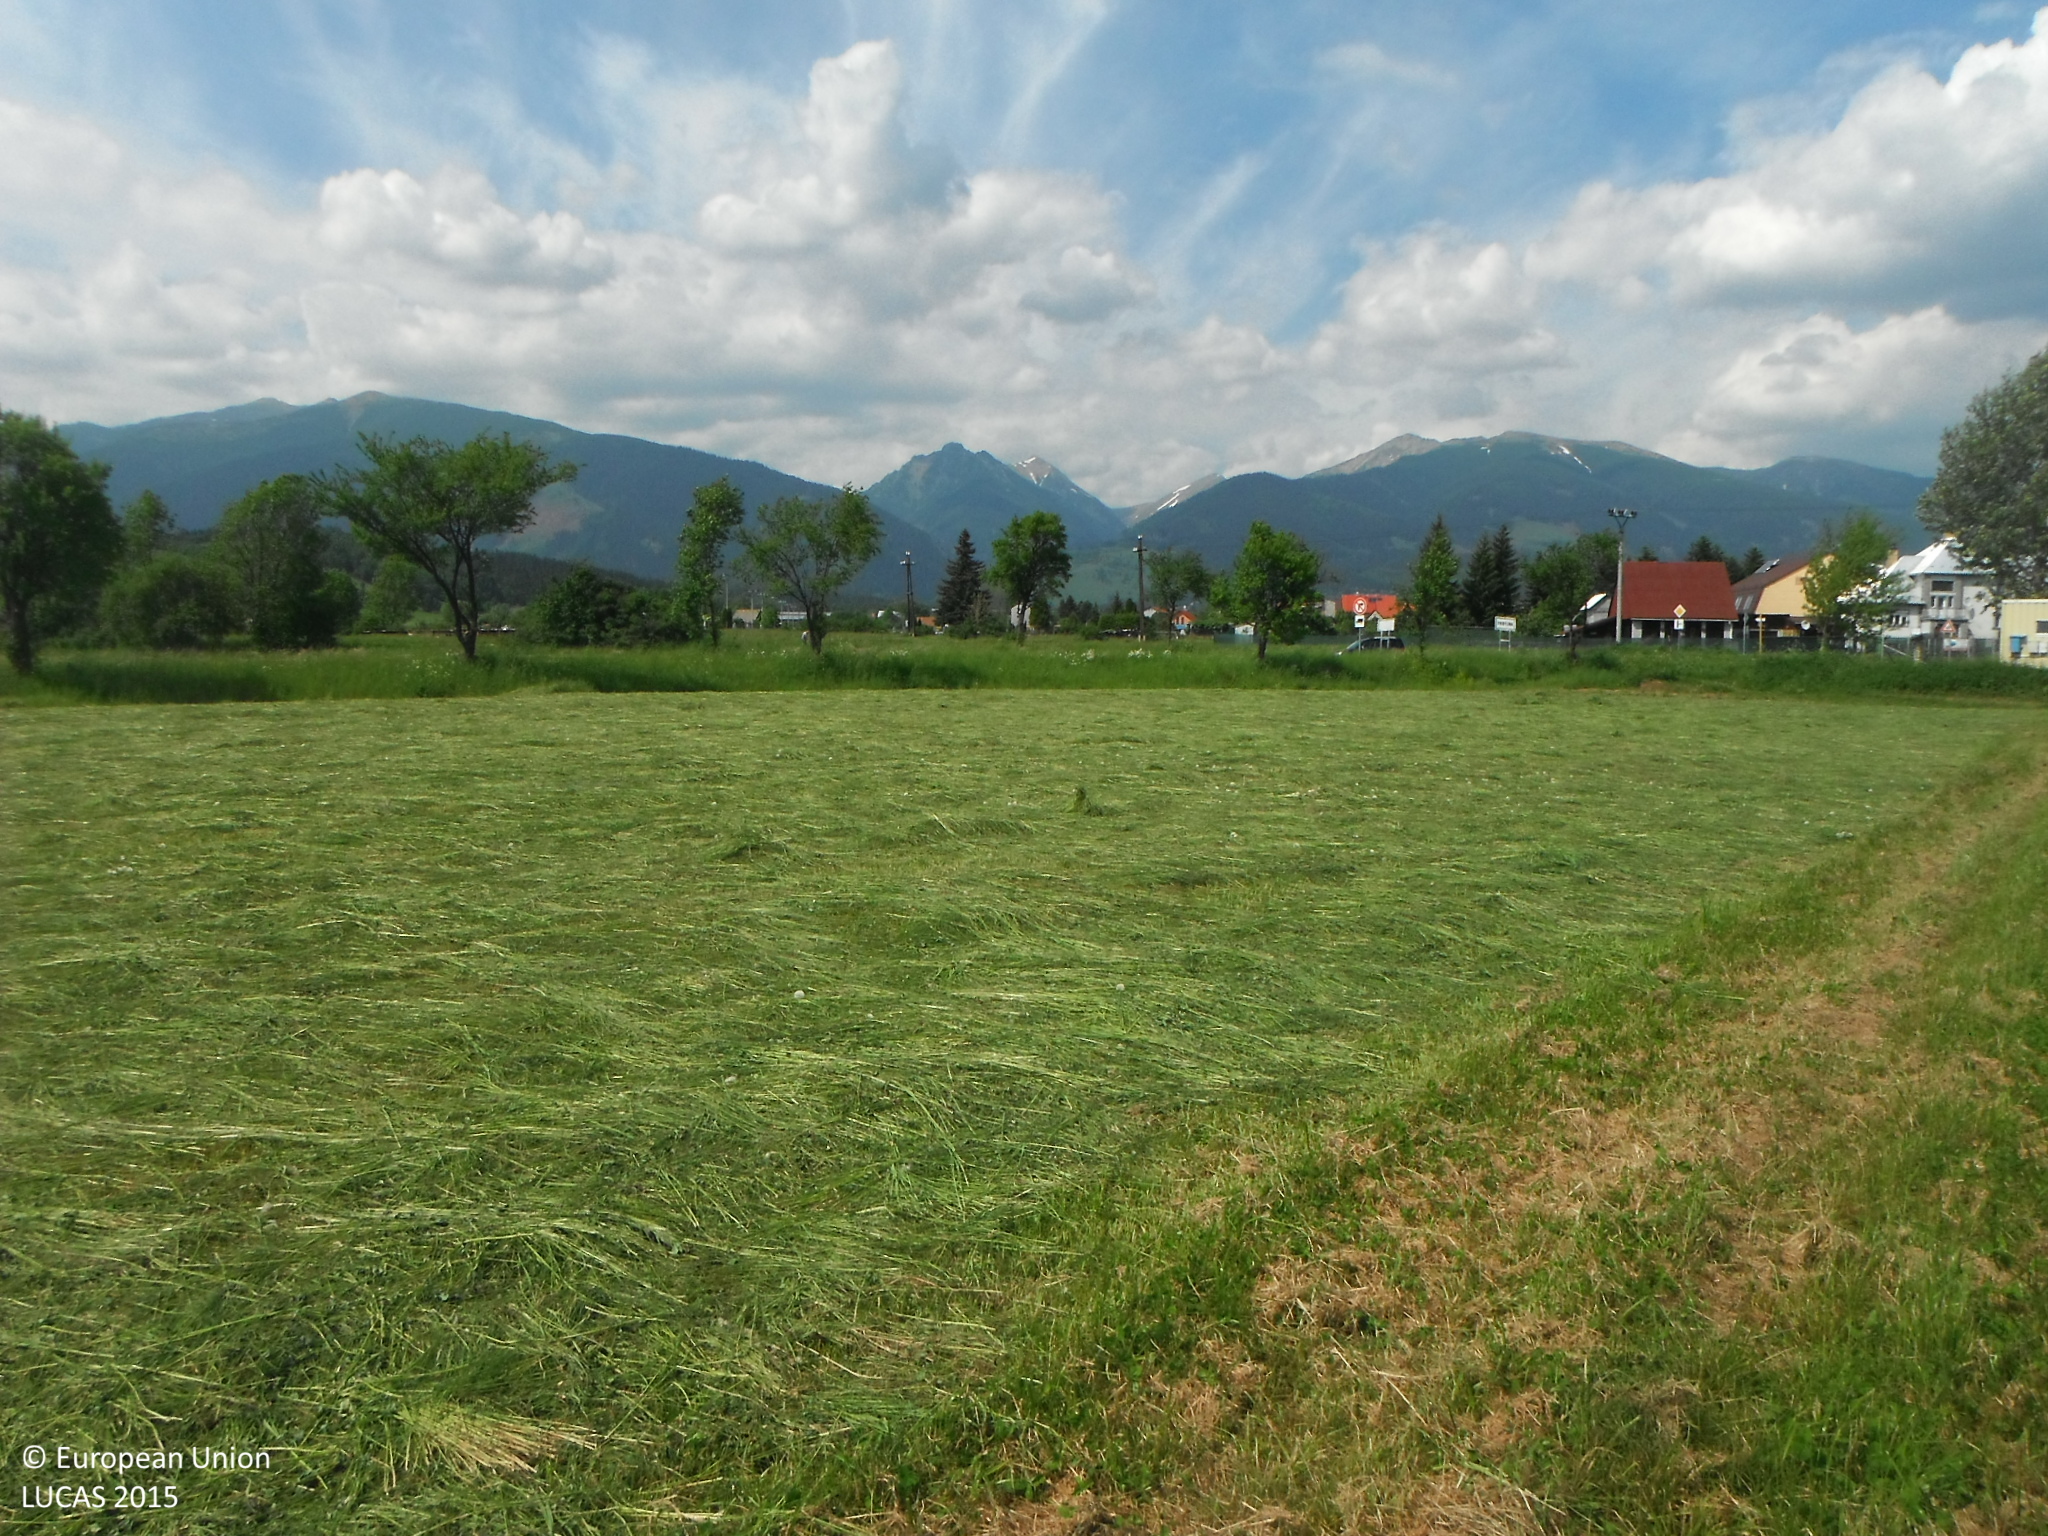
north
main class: Grassland
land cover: Grassland without tree/shrub cover
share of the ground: > 75 %
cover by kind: herbaceous plants 100 %
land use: Agriculture (excluding fallow land and kitchen gardens)
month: June
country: SK
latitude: 49.0914
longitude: 19.7926
